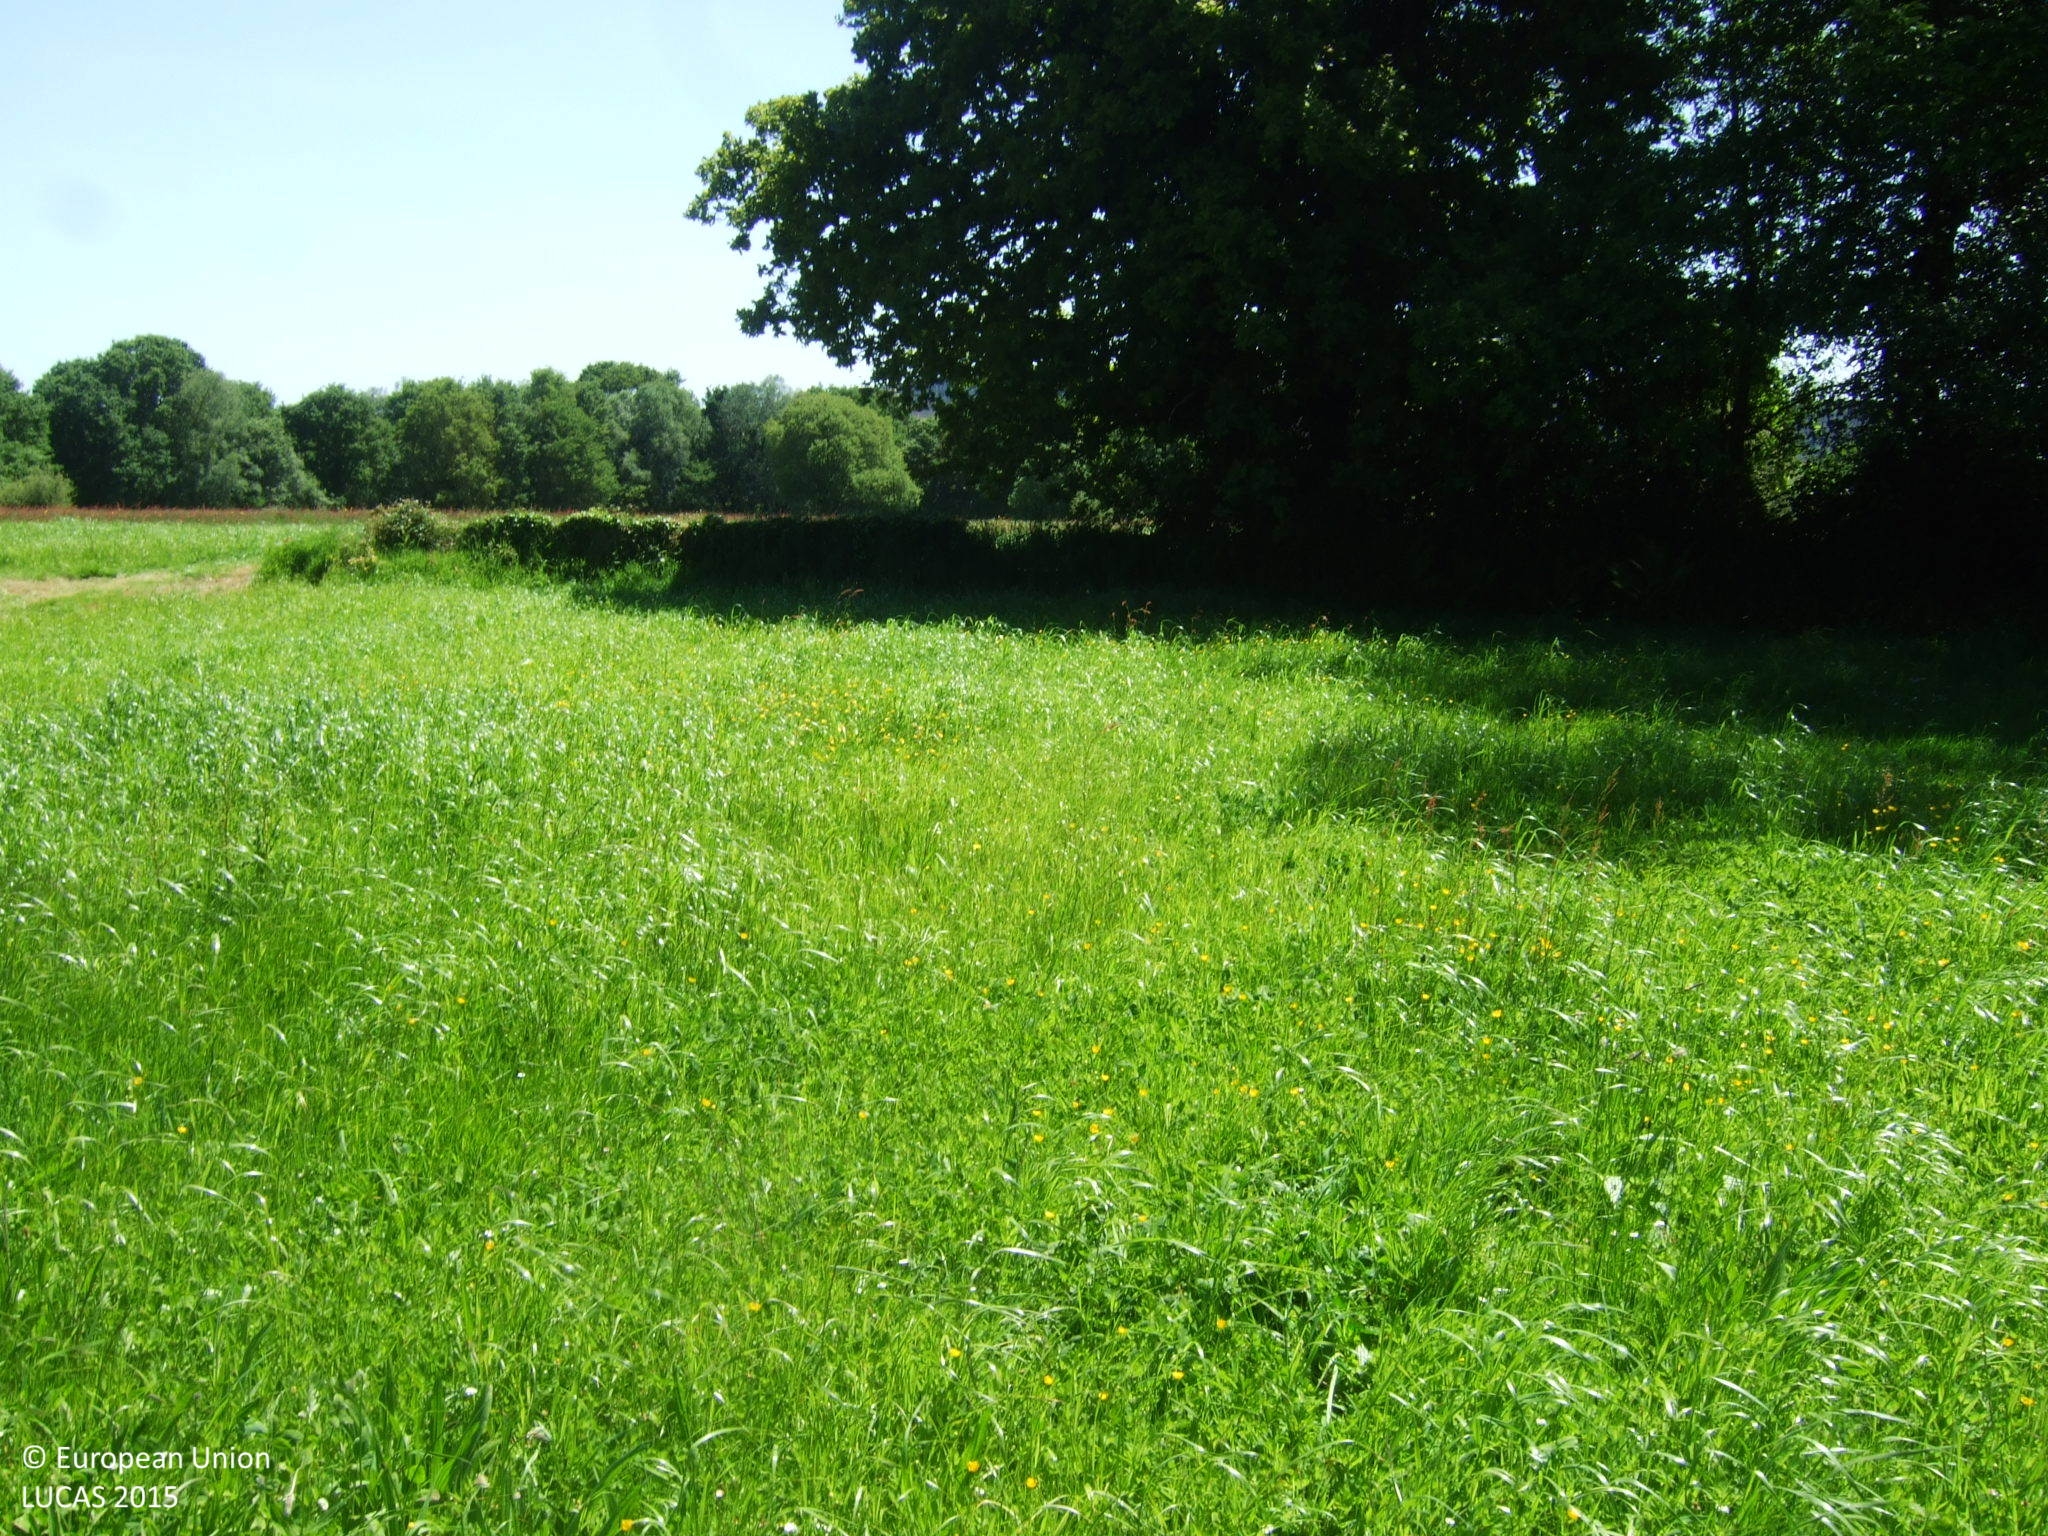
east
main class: Cropland
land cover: Temporary grasslands
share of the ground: > 75 %
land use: Agriculture (excluding fallow land and kitchen gardens)
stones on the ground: < 10 %
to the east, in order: Temporary grasslands; Shruby margins; Temporary grasslands; Grassland without tree/shrub cover; Temporary grasslands; Grassland without tree/shrub cover
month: May
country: ES
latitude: 43.2153
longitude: -7.7244
